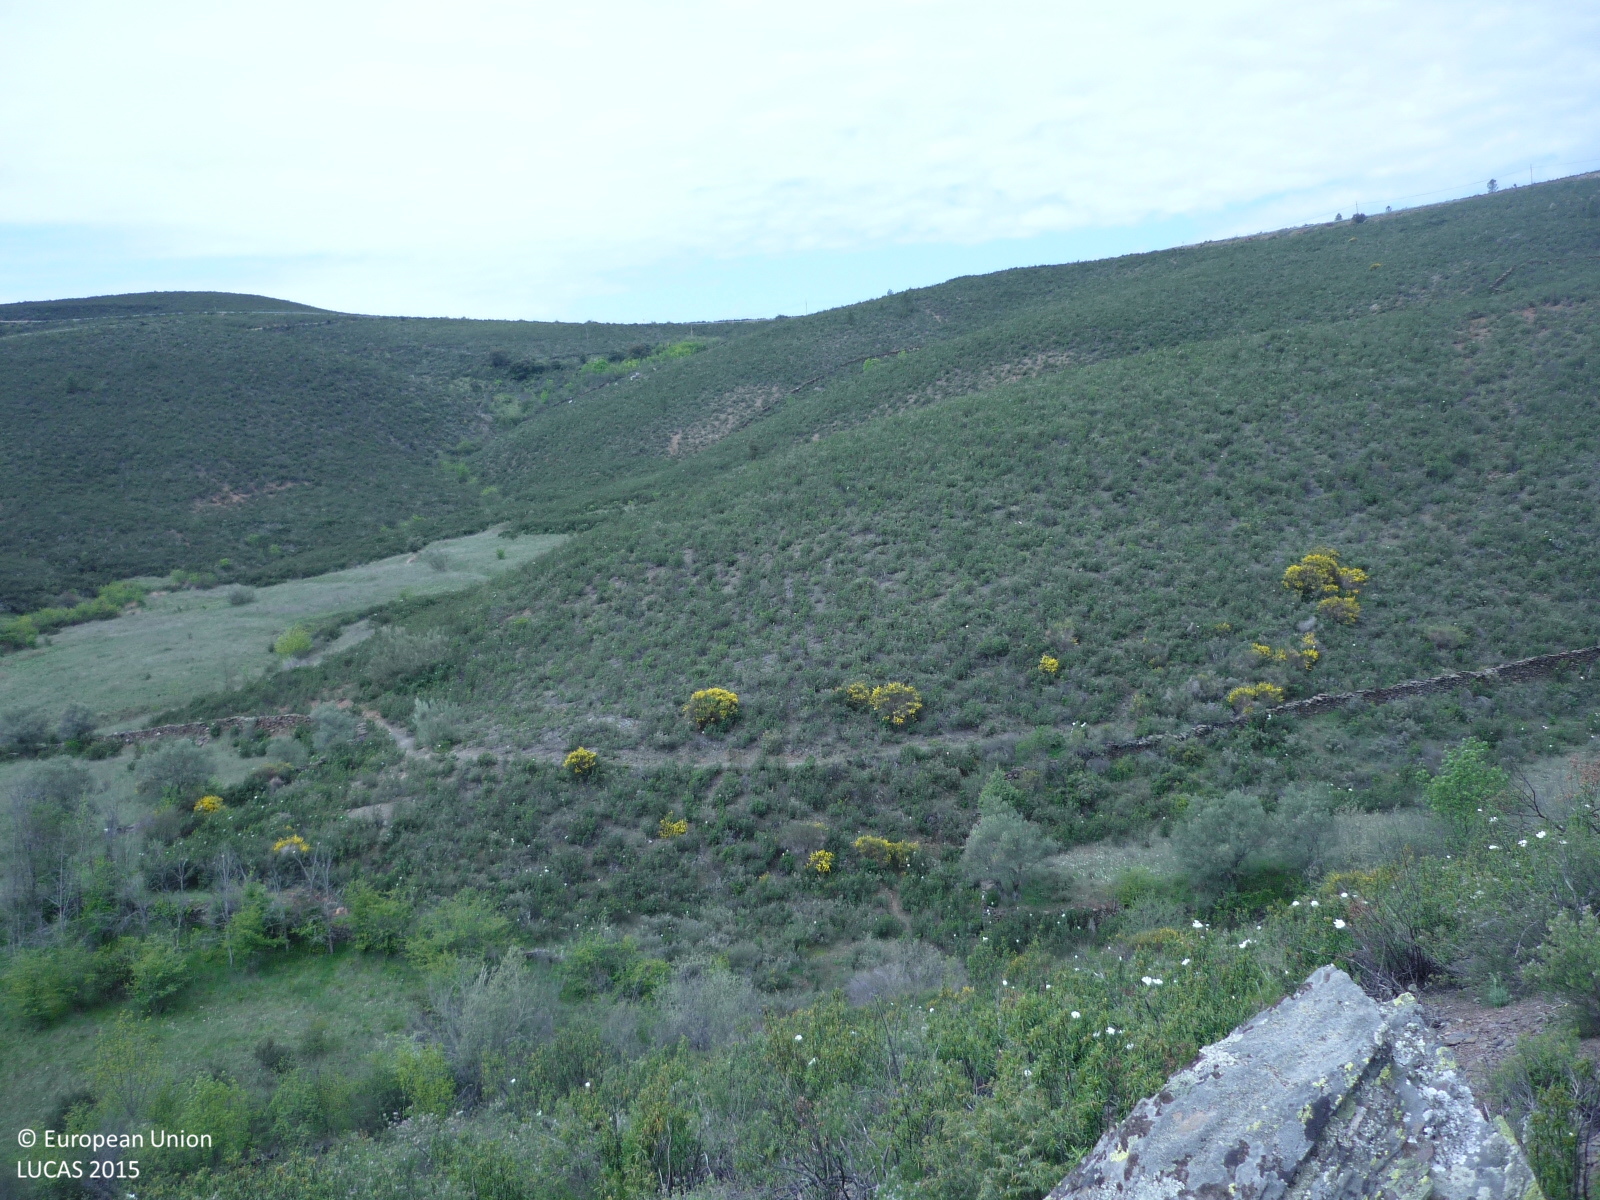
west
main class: Shrubland
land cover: Shrubland without tree cover
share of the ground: > 75 %
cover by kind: shrubs 65 %, unconsolidated bare surface 20 %, herbaceous plants 15 %
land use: Semi-natural and natural areas not in use
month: April
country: ES
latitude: 40.9263
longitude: -3.4718
